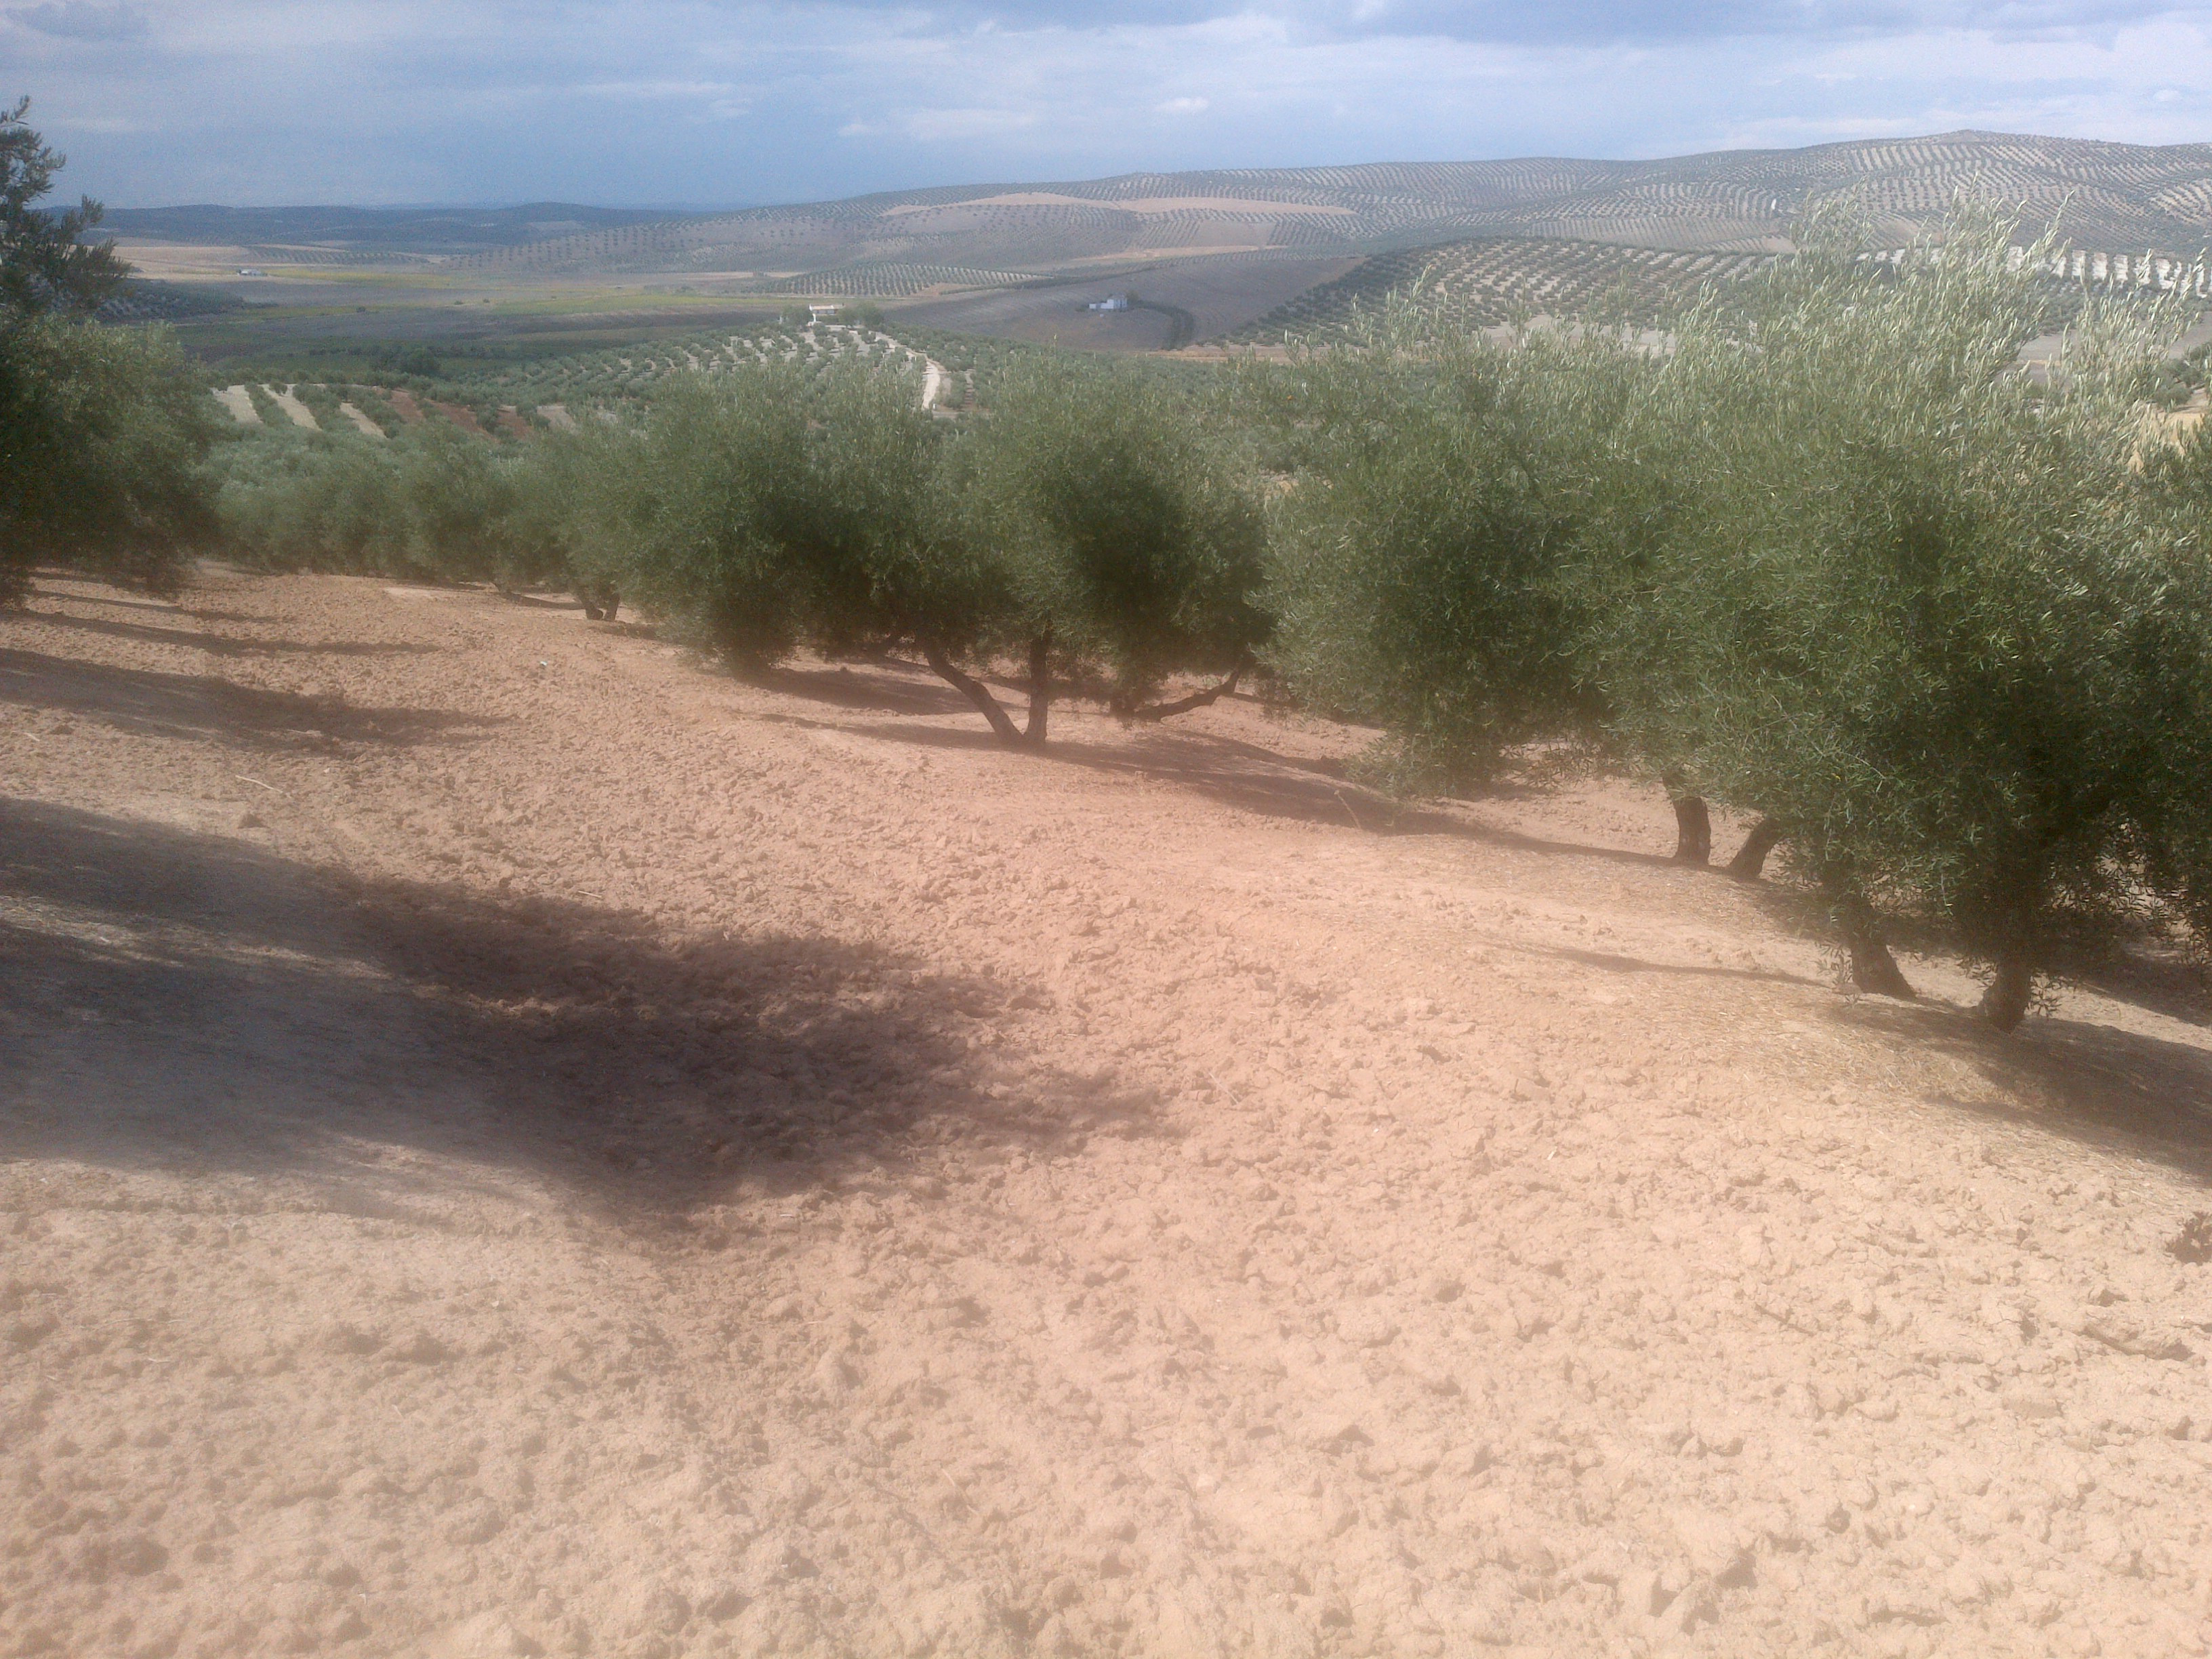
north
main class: Cropland
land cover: Olive groves
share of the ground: 50 - 75 %
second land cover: Other bare soil
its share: > 75 %
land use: Agriculture (excluding fallow land and kitchen gardens)
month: June
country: ES
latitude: 37.7706
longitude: -4.2534
